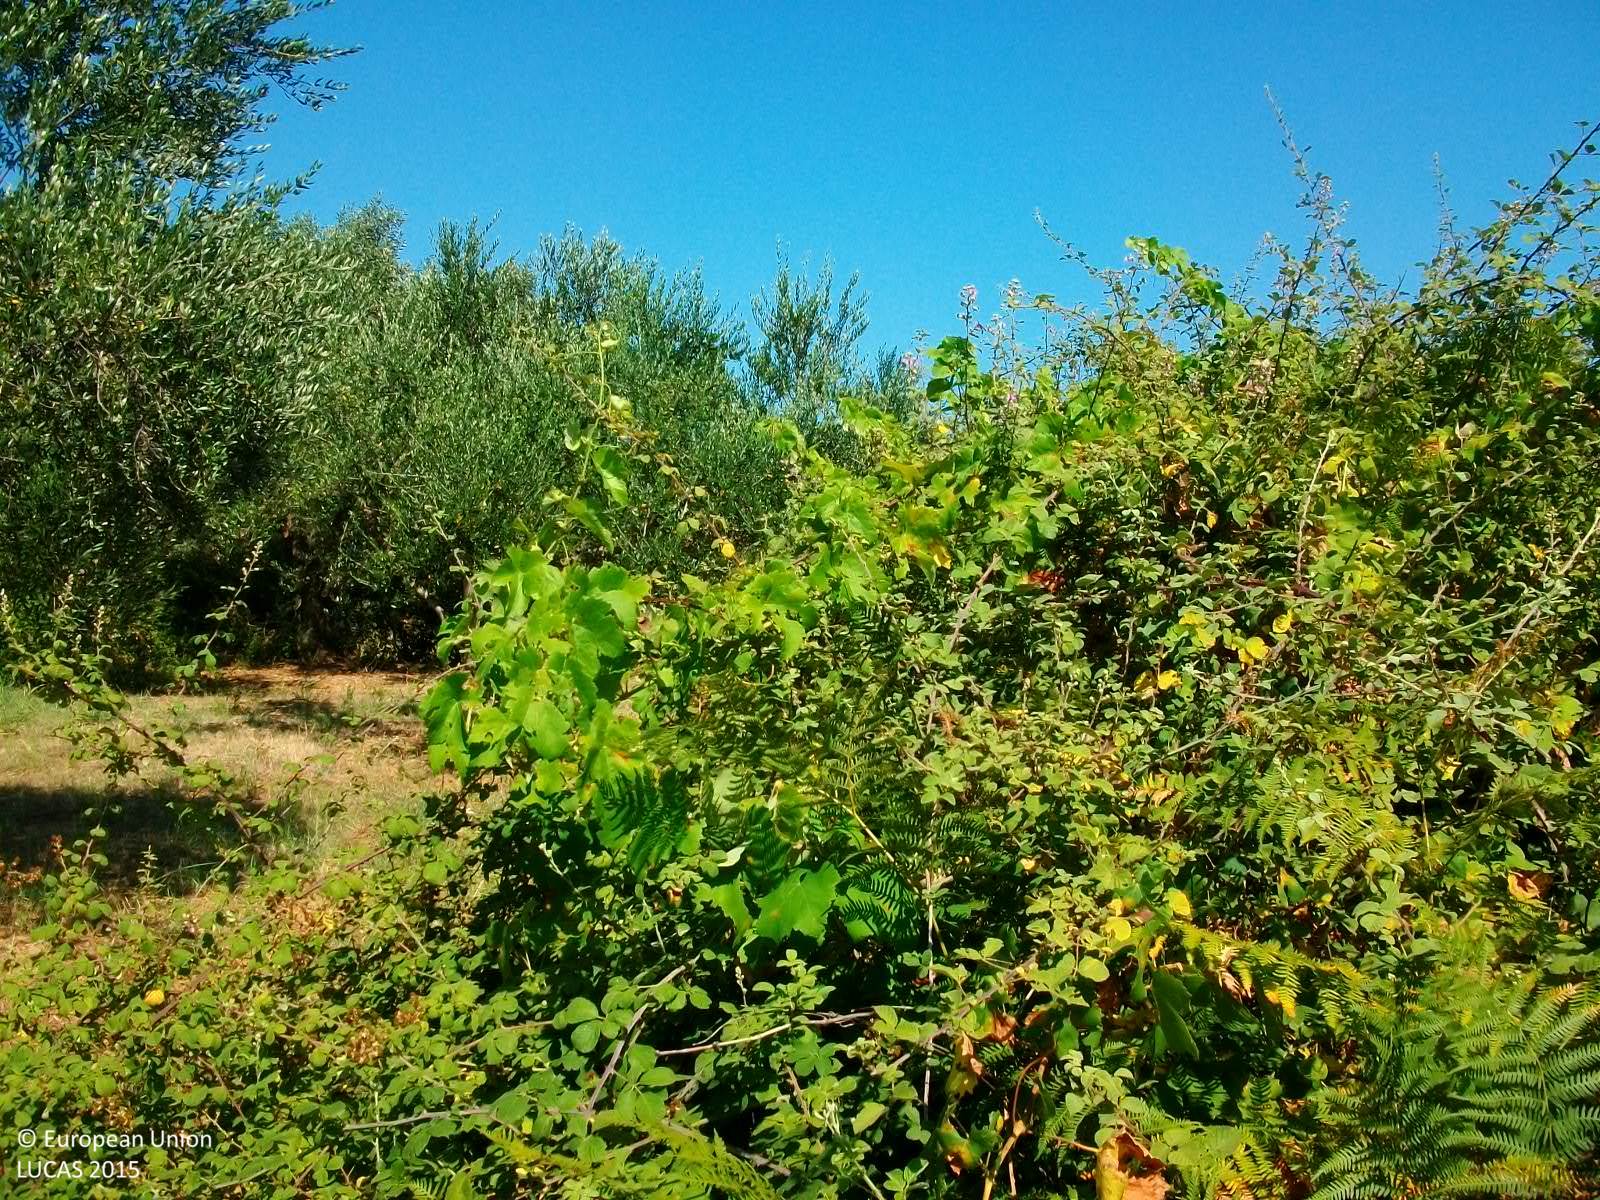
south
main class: Shrubland
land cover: Shrubland without tree cover
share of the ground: > 75 %
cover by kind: shrubs 100 %
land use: Abandoned areas
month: July
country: GR
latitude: 37.0365
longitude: 21.8805
